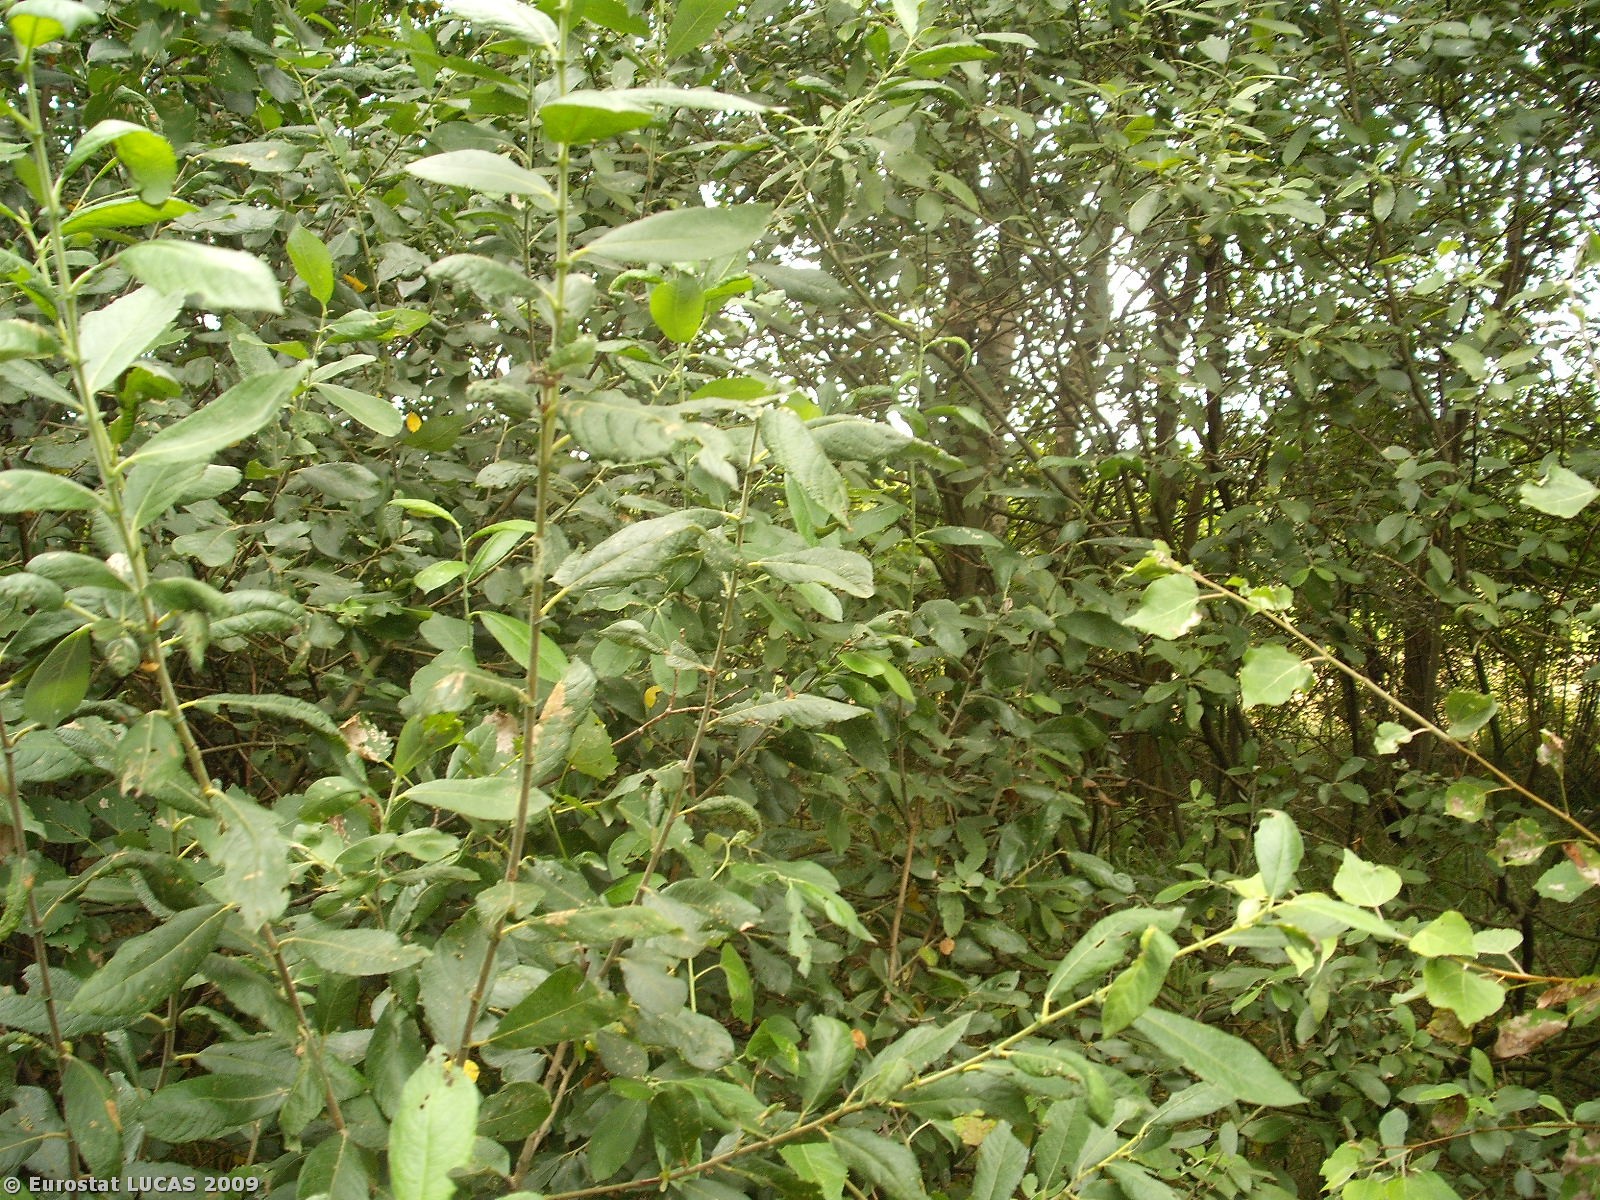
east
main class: Woodland
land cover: Broadleaved woodland
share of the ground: > 75 %
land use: Unused
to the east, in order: Broadleaved woodland; Rye; Grassland without tree/shrub cover; Electric lines; Grassland without tree/shrub cover; Rye; Oats; Grass margins; Paved roads, cycling and walking lanes; Grass margins; Rye; Abandoned hedges; Paved roads, cycling and walking lanes; Grassland without tree/shrub cover
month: August
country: PL
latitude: 52.3749
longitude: 21.7321
